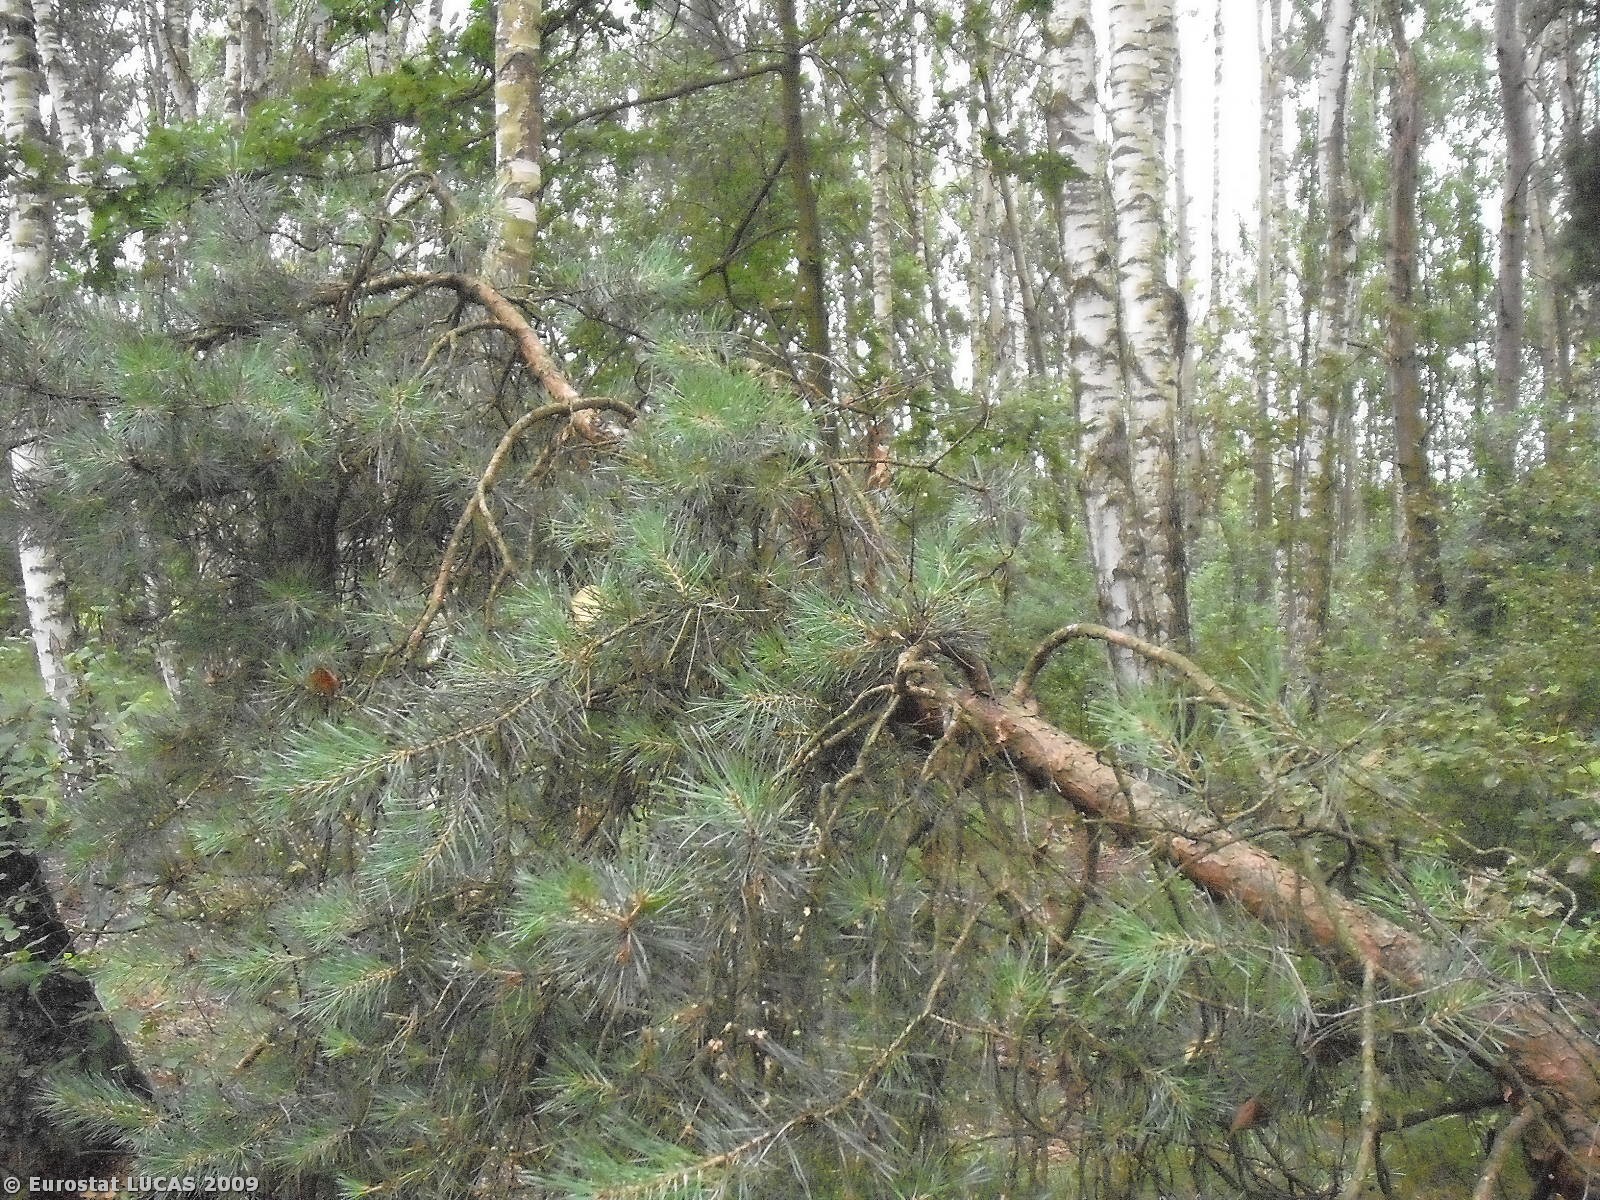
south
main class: Woodland
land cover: Broadleaved woodland
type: mesophytic deciduous forest
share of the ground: > 75 %
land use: Forestry
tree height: > 5 m
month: July
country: PL
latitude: 51.6373
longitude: 21.0993
